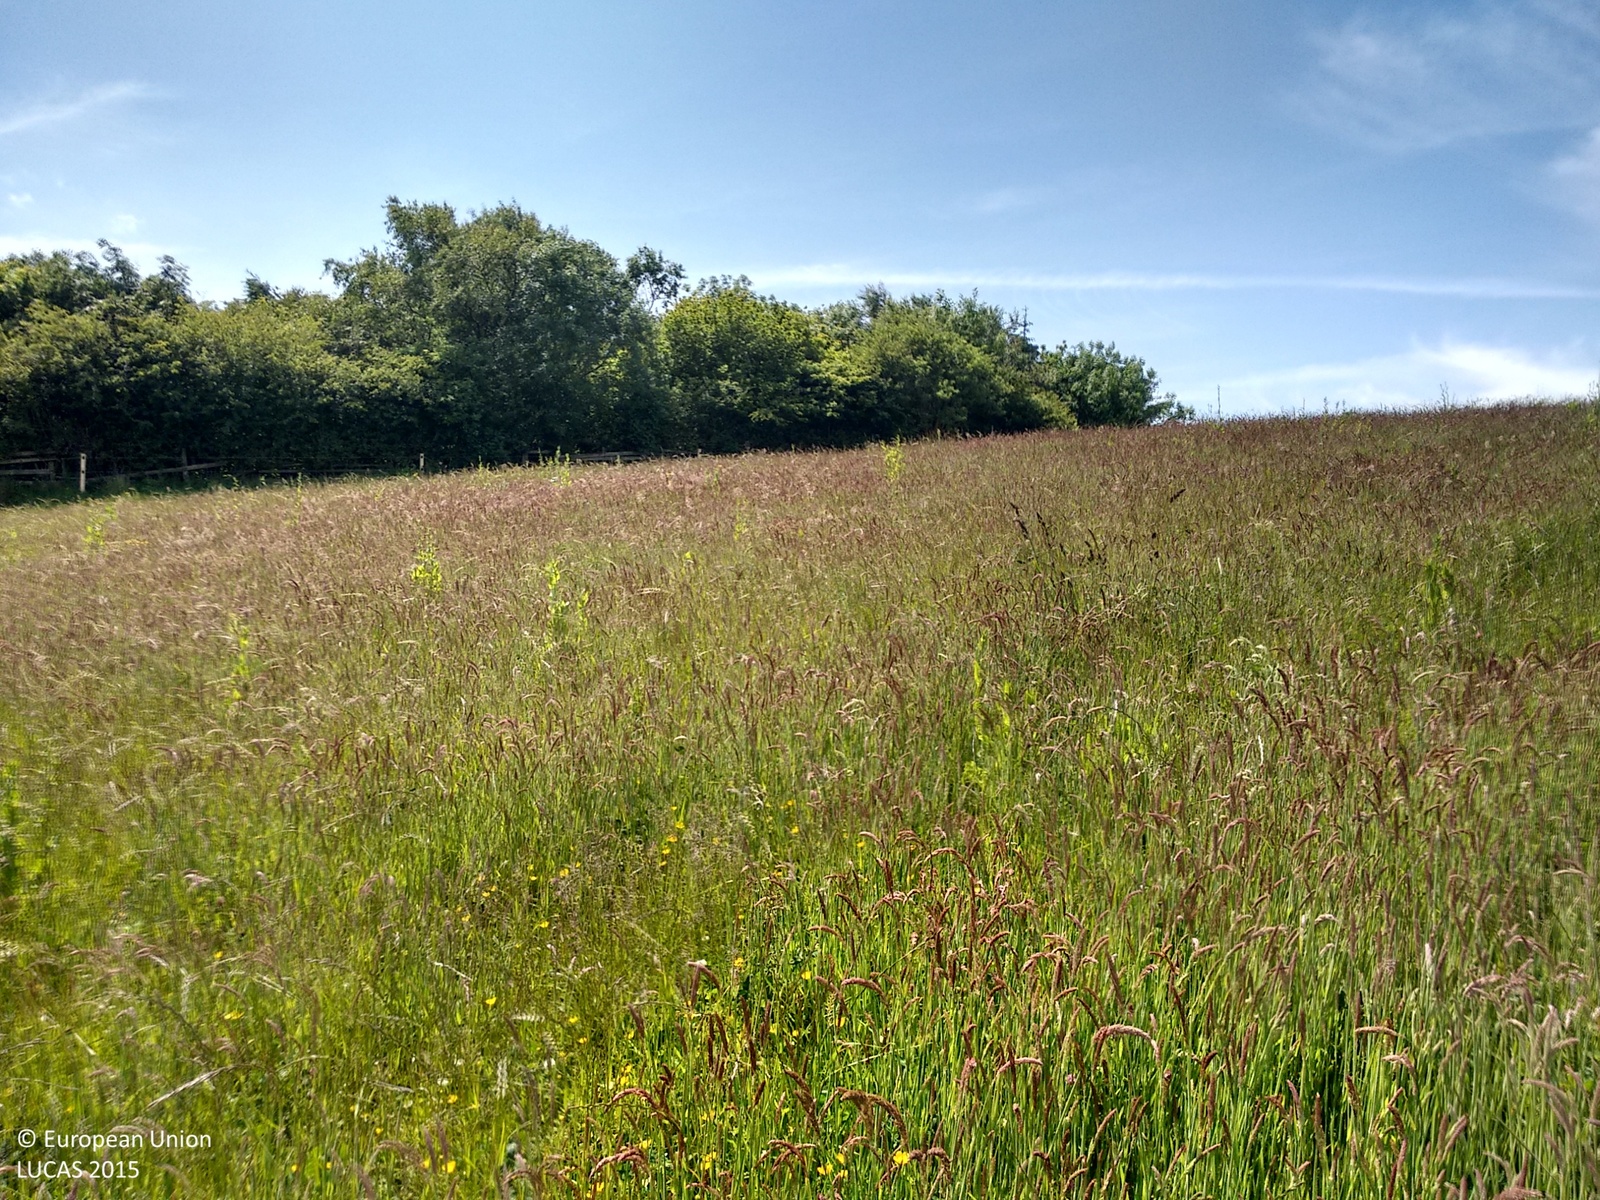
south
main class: Grassland
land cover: Grassland without tree/shrub cover
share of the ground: > 75 %
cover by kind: herbaceous plants 100 %
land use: Agriculture (excluding fallow land and kitchen gardens)
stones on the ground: < 10 %
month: June
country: GB
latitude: 54.3246
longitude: -0.4757
